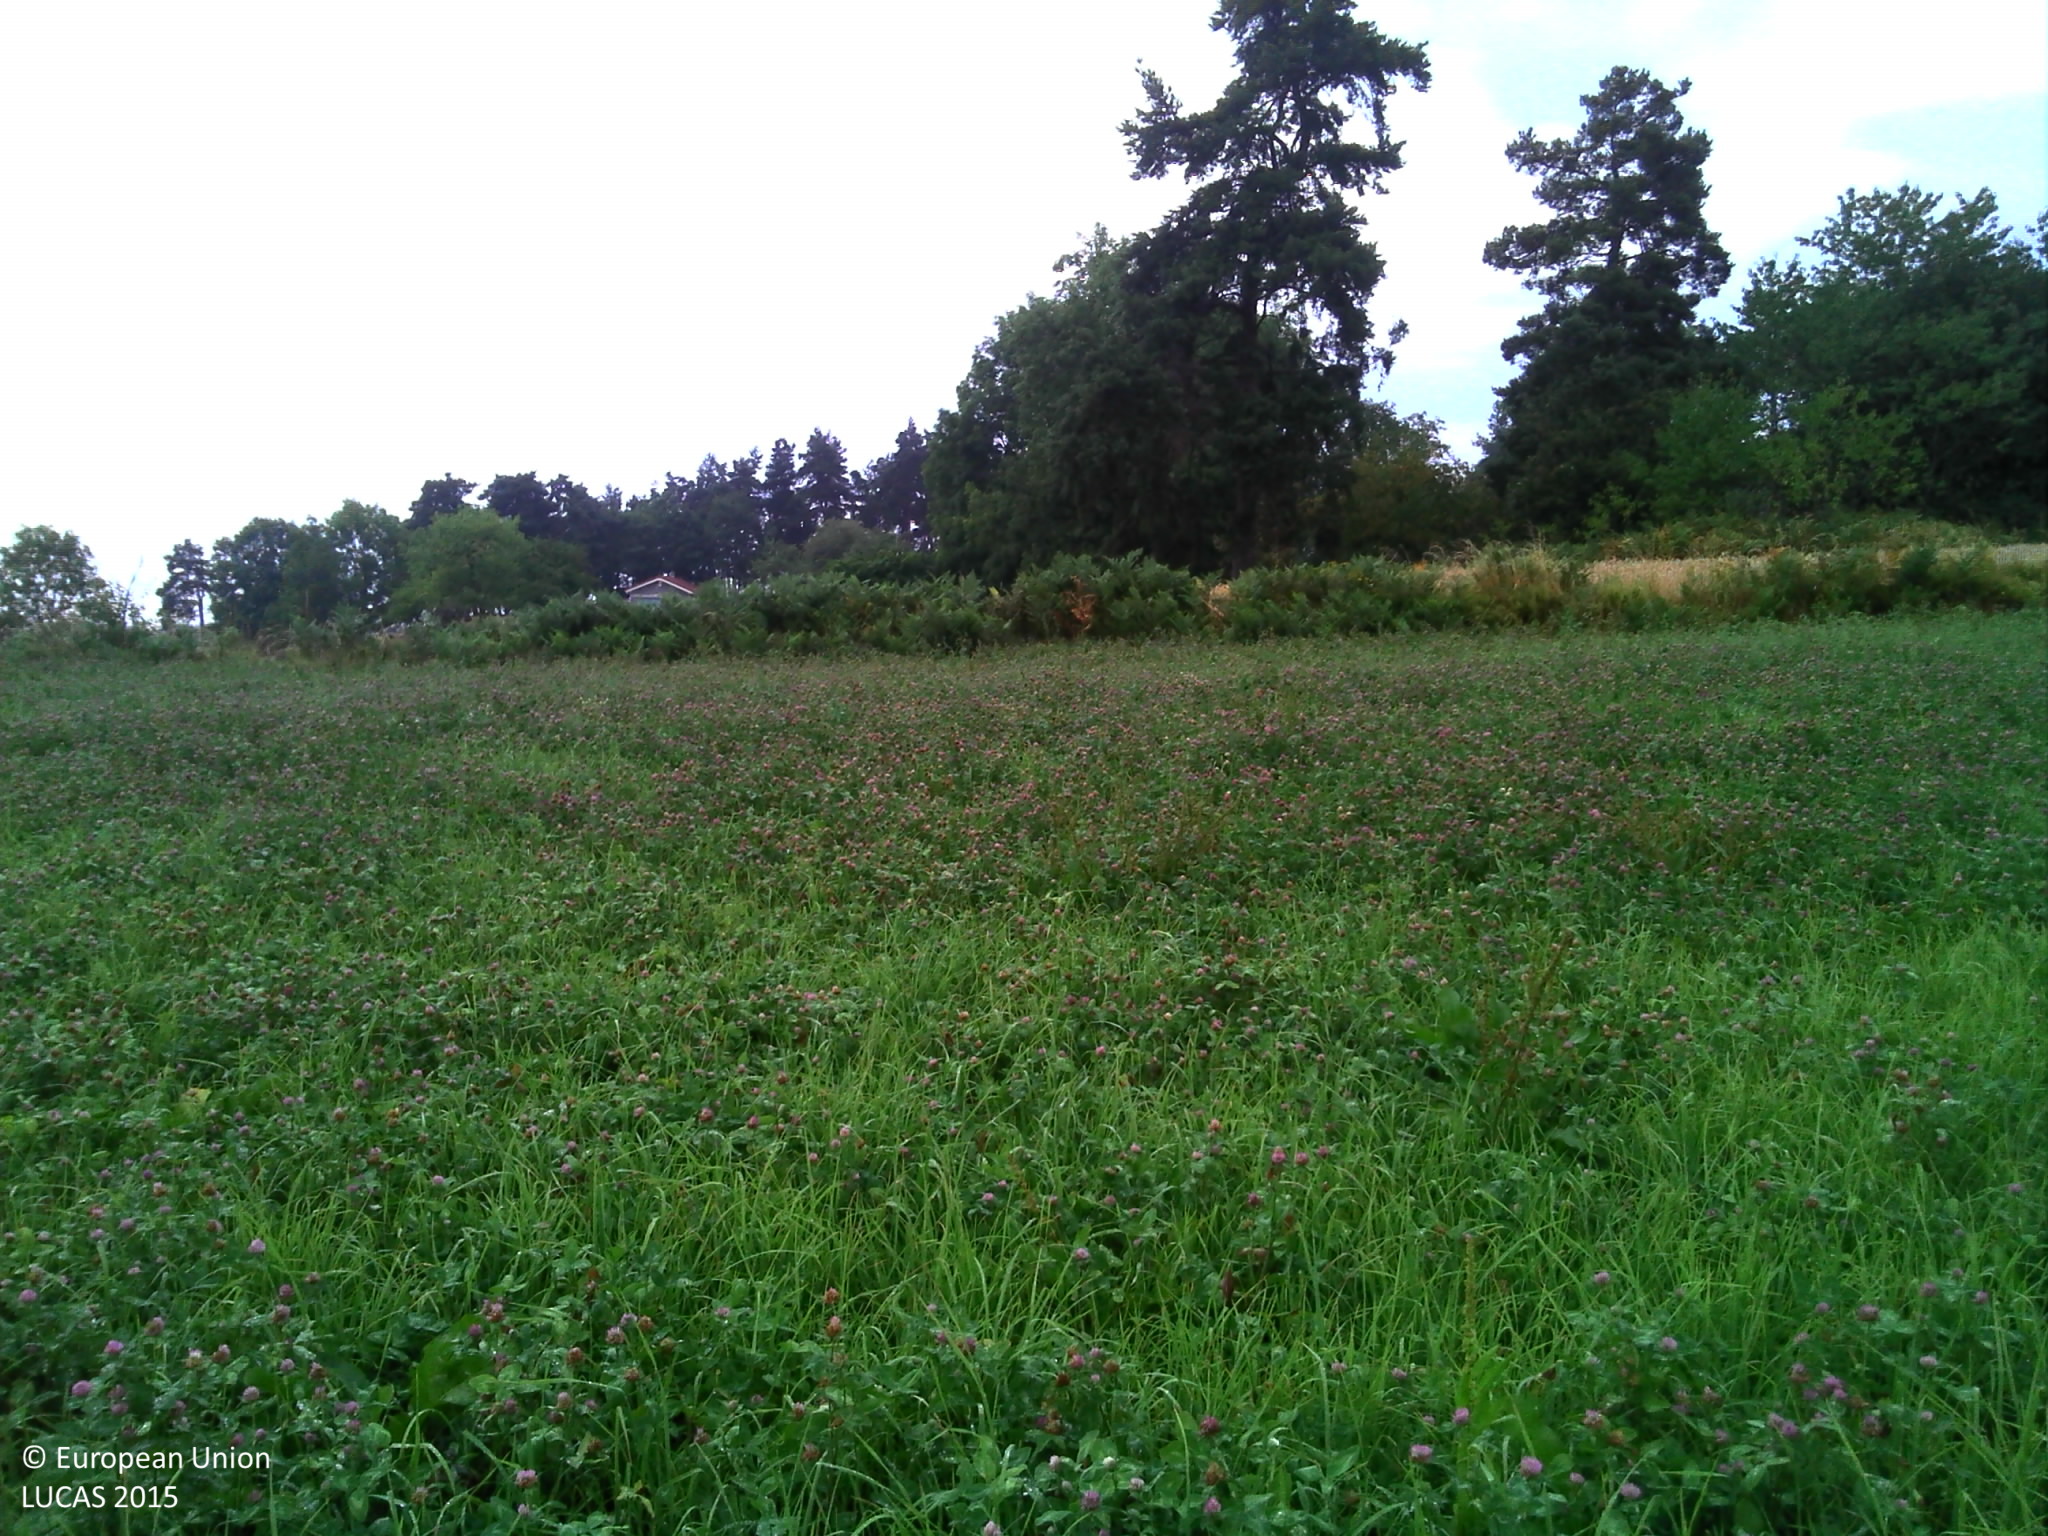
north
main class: Cropland
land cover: Clovers
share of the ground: > 75 %
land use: Kitchen garden
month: July
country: FR
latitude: 45.2564
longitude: 4.2316
